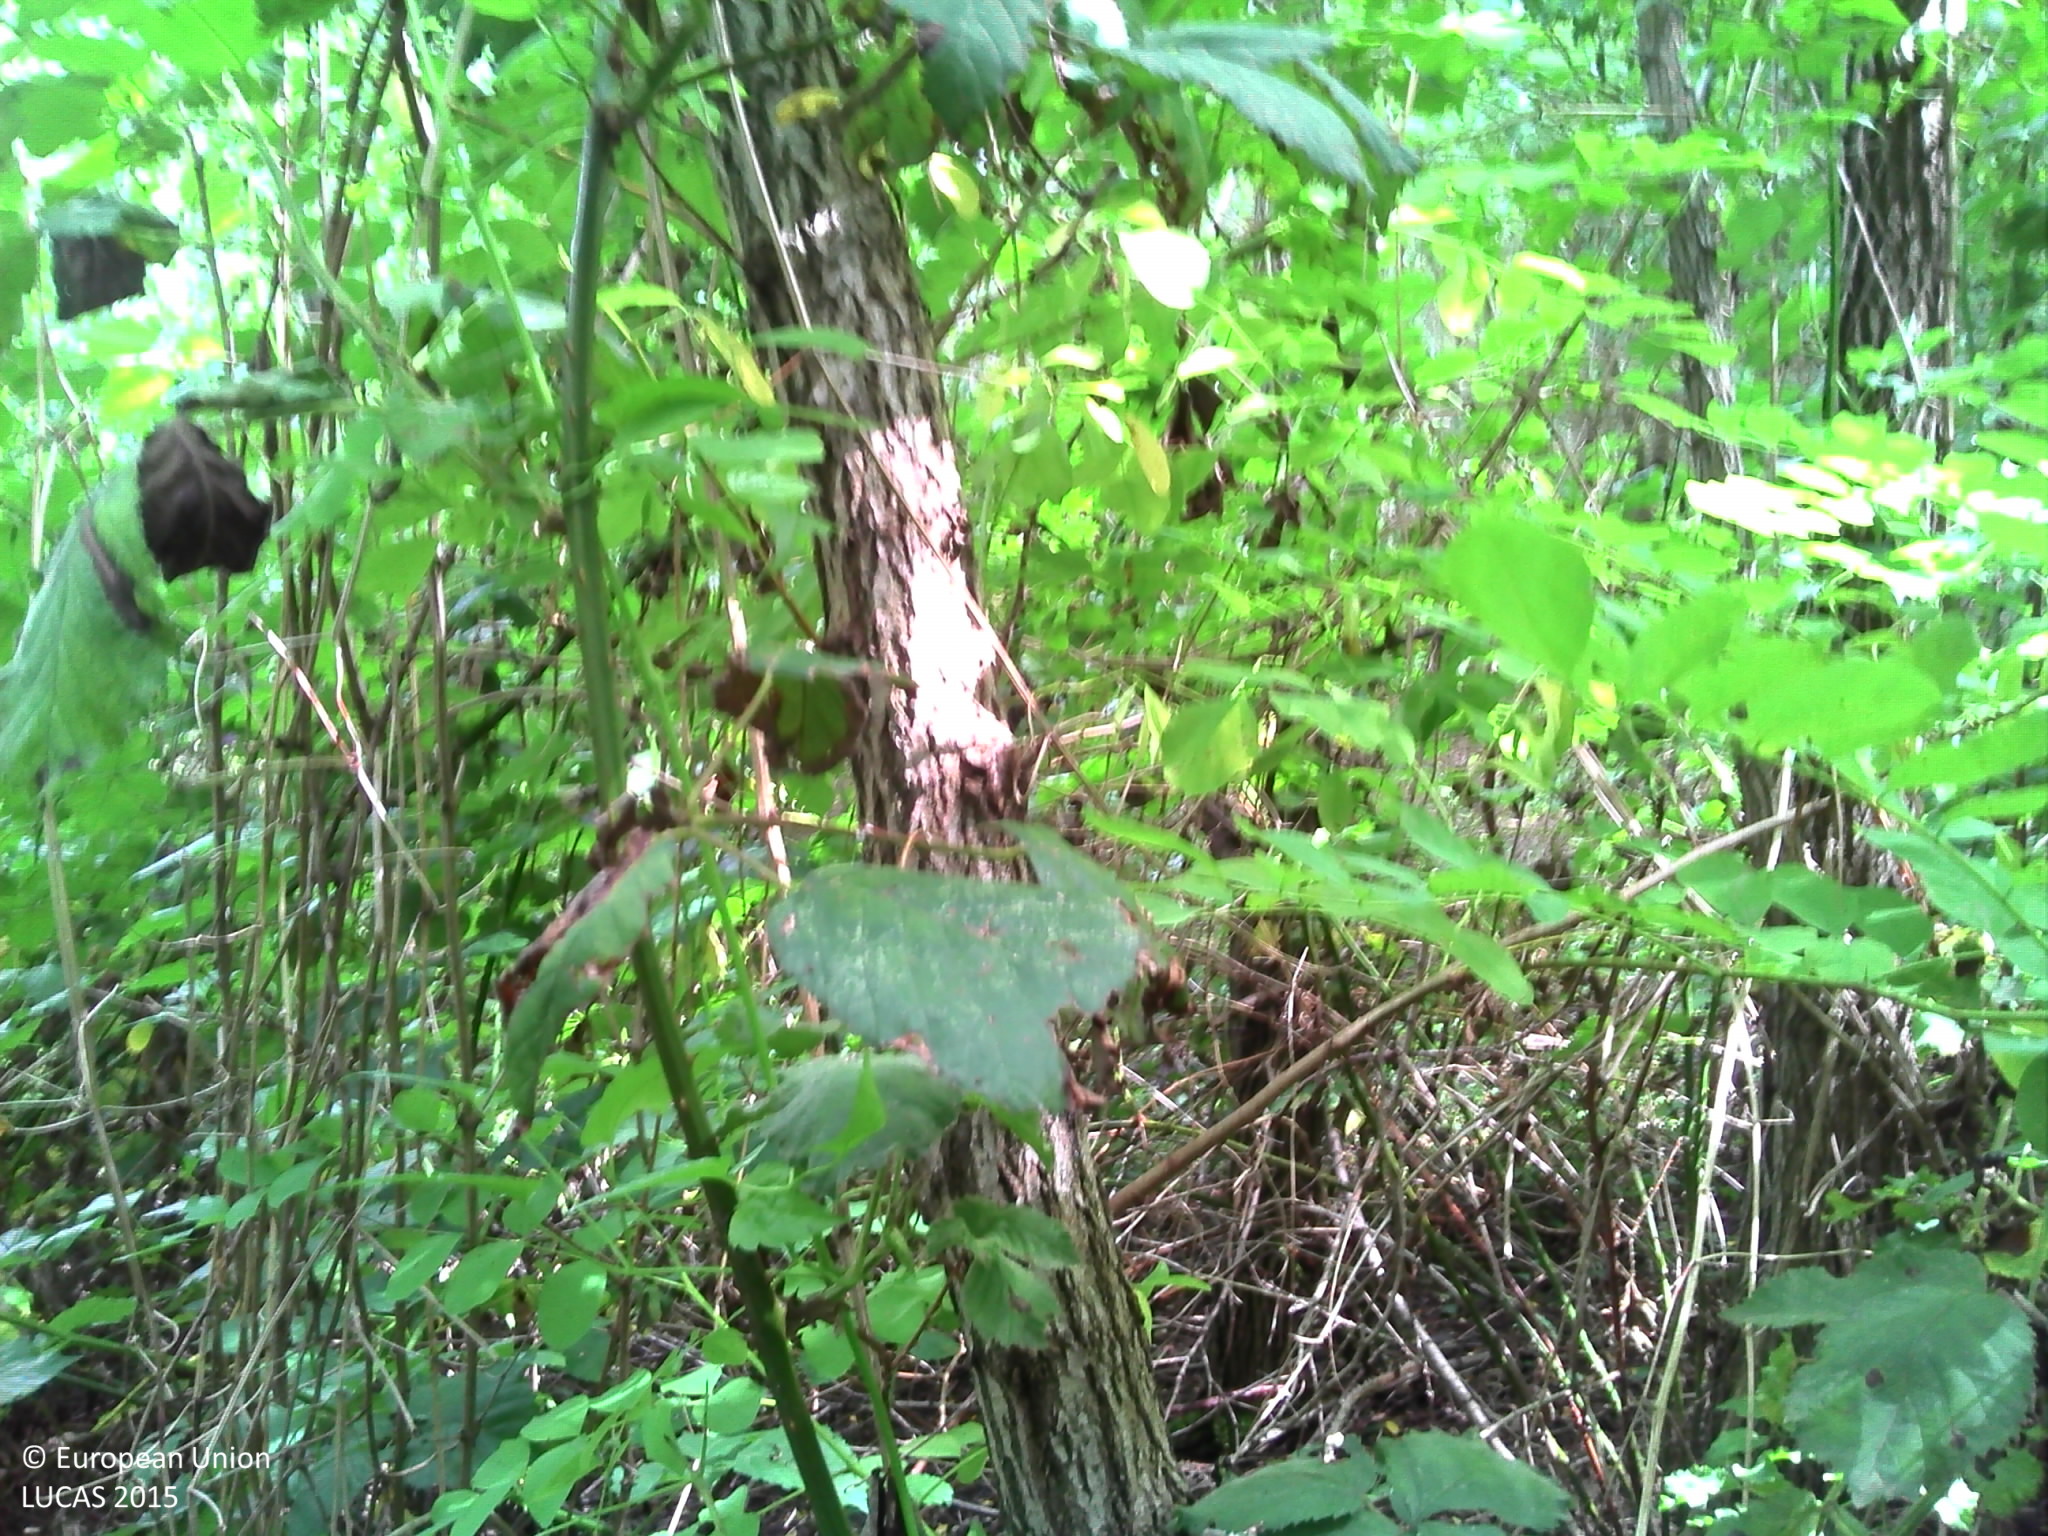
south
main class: Woodland
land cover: Broadleaved woodland
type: mesophytic deciduous forest
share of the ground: > 75 %
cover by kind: broadleaved forest trees 50 %, shrubs 40 %, herbaceous plants 5 %
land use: Semi-natural and natural areas not in use
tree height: > 5 m
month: July
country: BE
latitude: 50.4269
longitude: 4.4354
